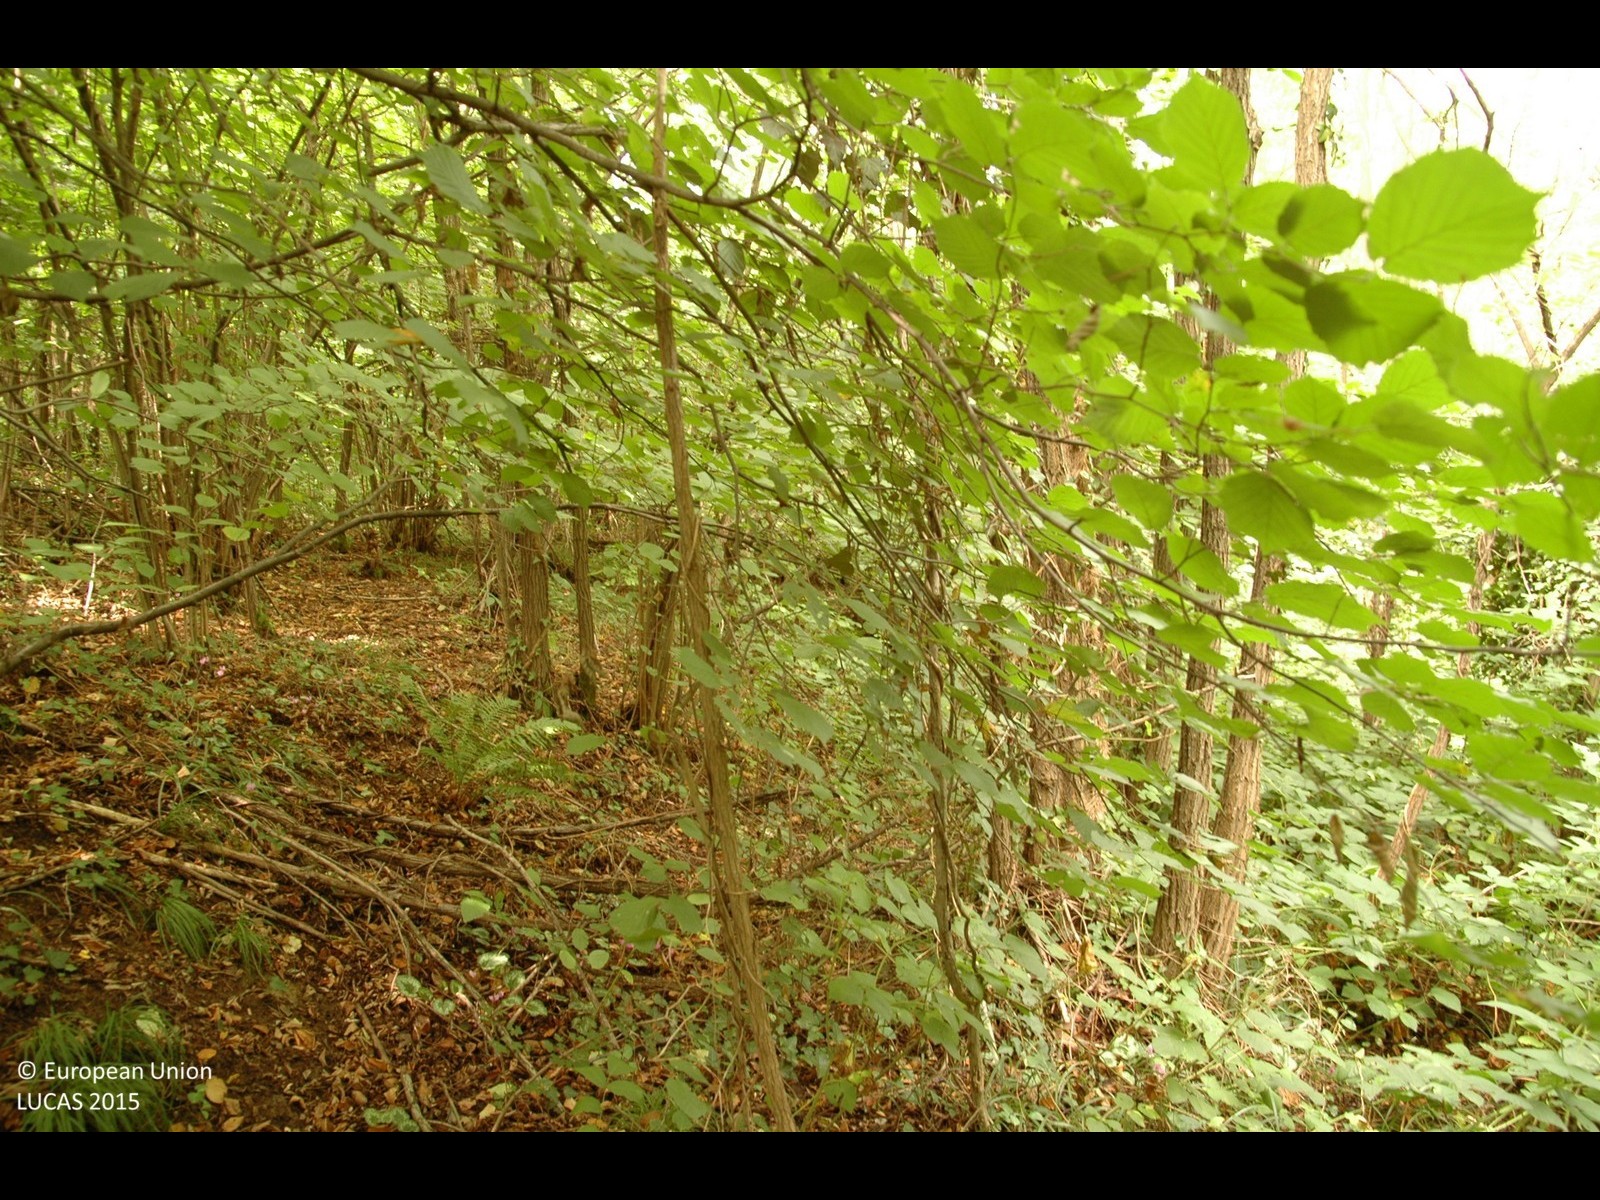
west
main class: Woodland
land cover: Broadleaved woodland
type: mesophytic deciduous forest
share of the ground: > 75 %
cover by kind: broadleaved forest trees 100 %
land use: Forestry
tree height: > 5 m
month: August
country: HR
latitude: 45.9034
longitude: 16.1471
